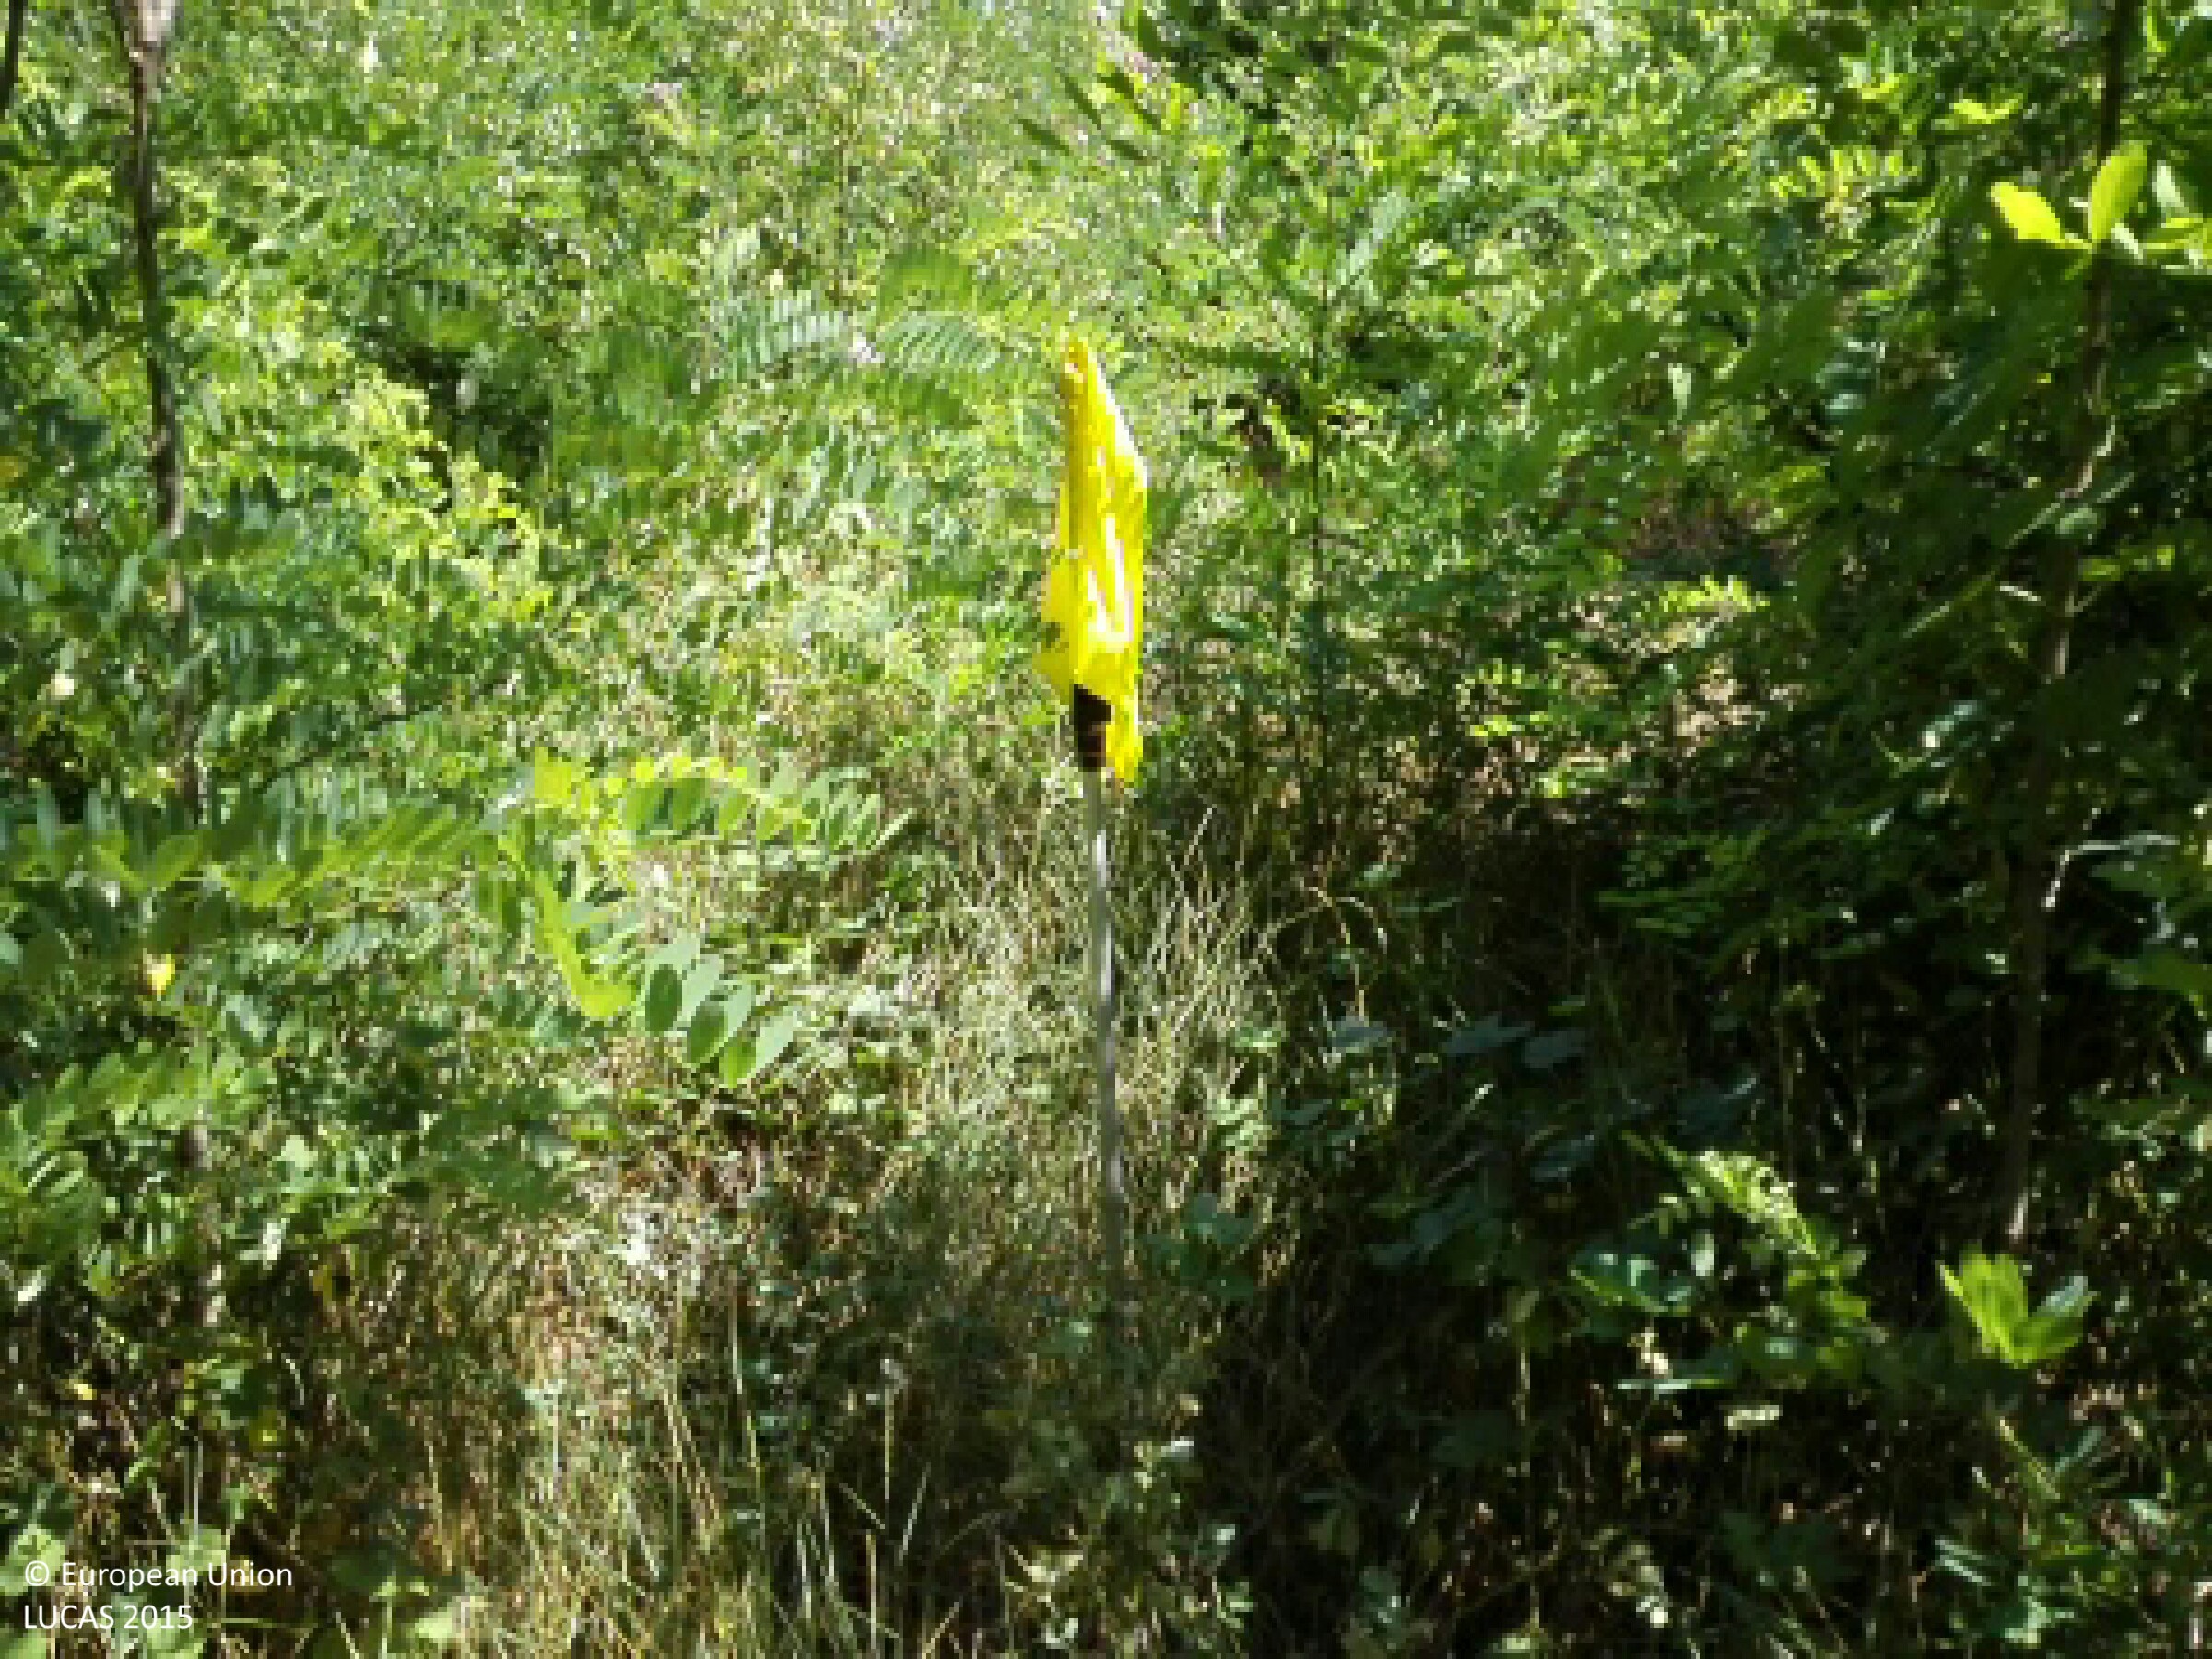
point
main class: Woodland
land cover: Broadleaved woodland
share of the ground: > 75 %
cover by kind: broadleaved forest trees 70 %, shrubs 25 %, herbaceous plants 5 %
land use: Semi-natural and natural areas not in use
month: July
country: HU
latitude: 47.6559
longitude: 21.6694
